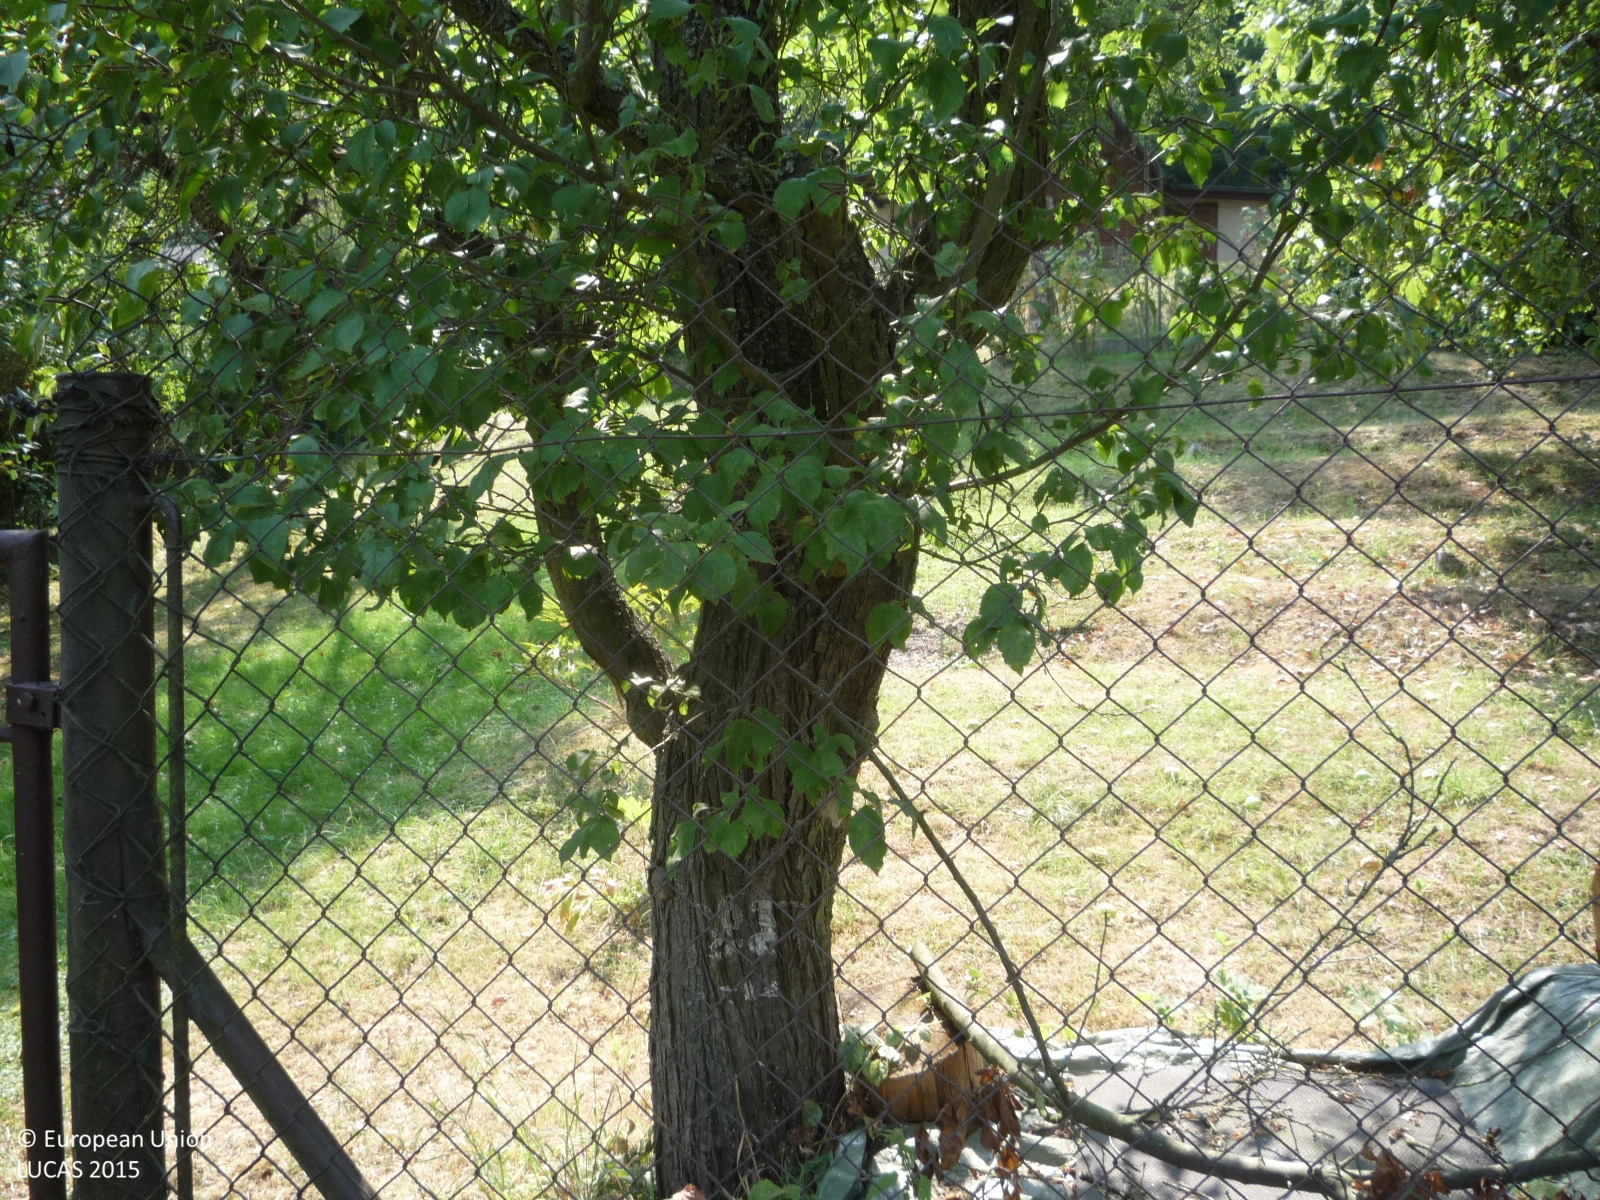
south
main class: Cropland
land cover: Apple fruit
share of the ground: 25 - 50 %
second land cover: Grassland without tree/shrub cover
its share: 25 - 50 %
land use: Kitchen garden
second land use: Amenities, museums, leisure
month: August
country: CZ
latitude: 49.8795
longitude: 14.4966
